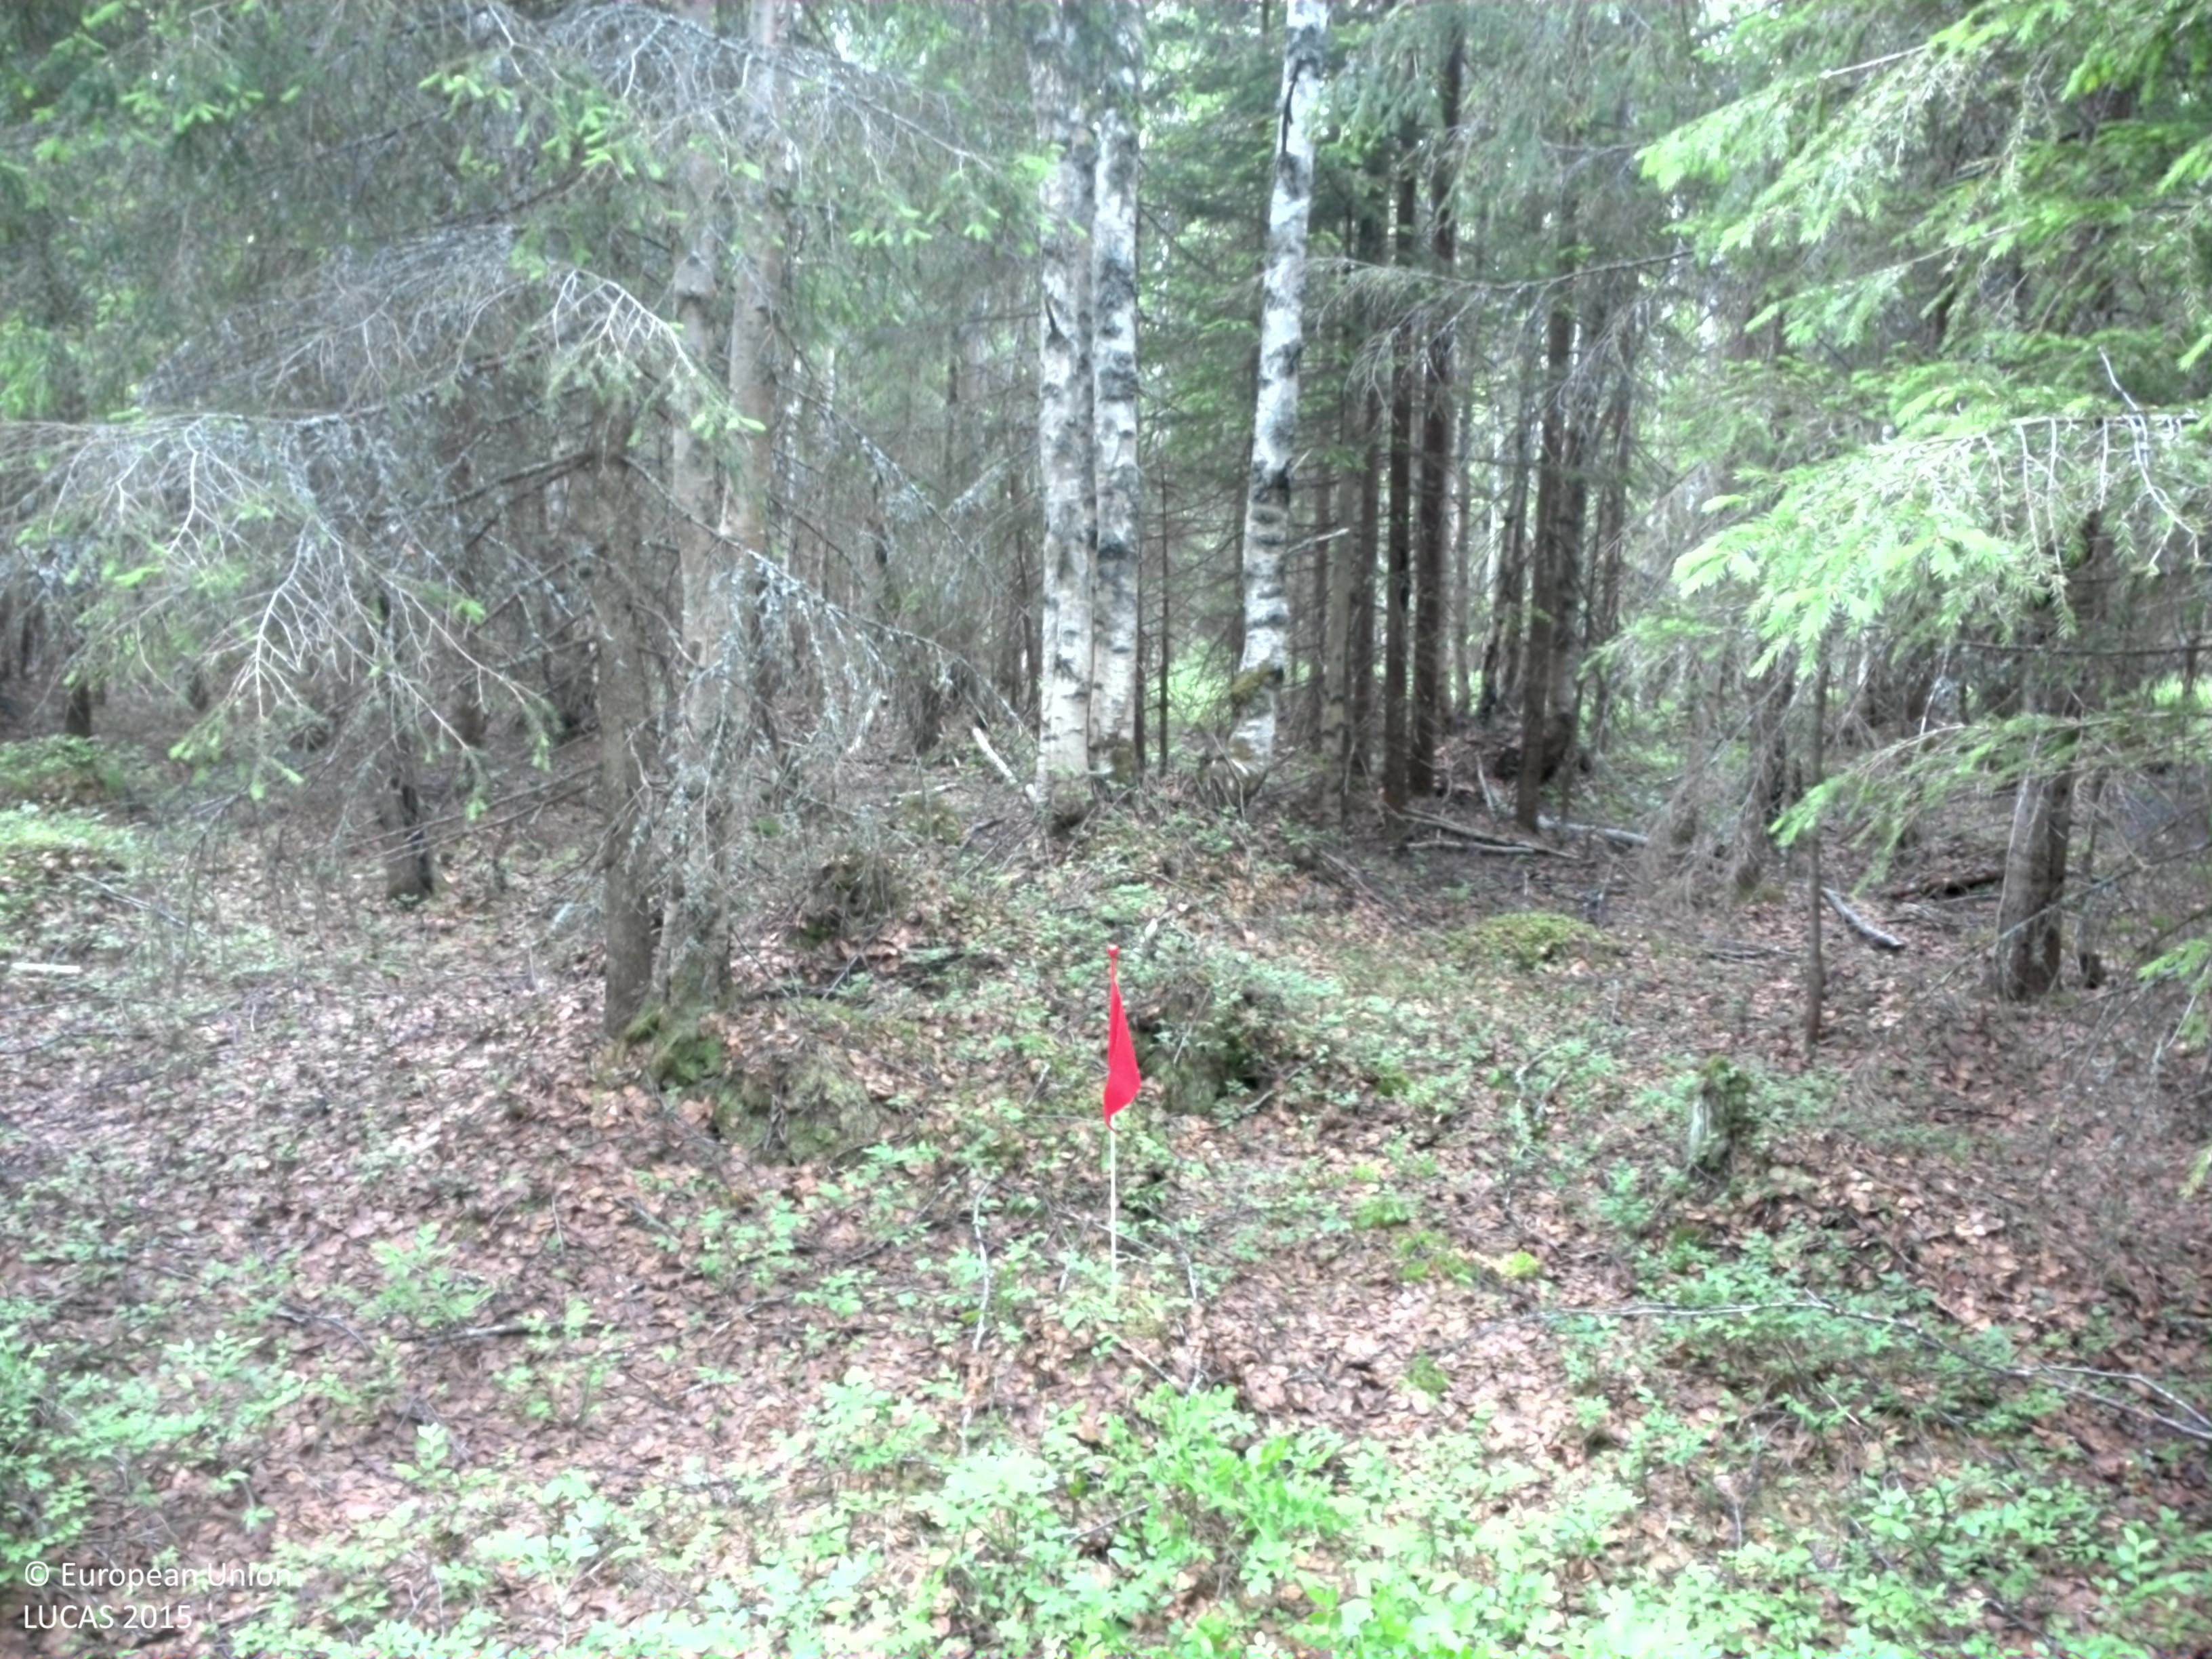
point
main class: Woodland
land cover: Other mixed woodland
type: boreal forest
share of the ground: > 75 %
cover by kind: coniferous forest trees 55 %, broadleaved forest trees 30 %, shrubs 15 %
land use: Forestry
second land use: Amenities, museums, leisure
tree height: > 5 m
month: July
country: SE
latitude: 64.4361
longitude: 20.7174
